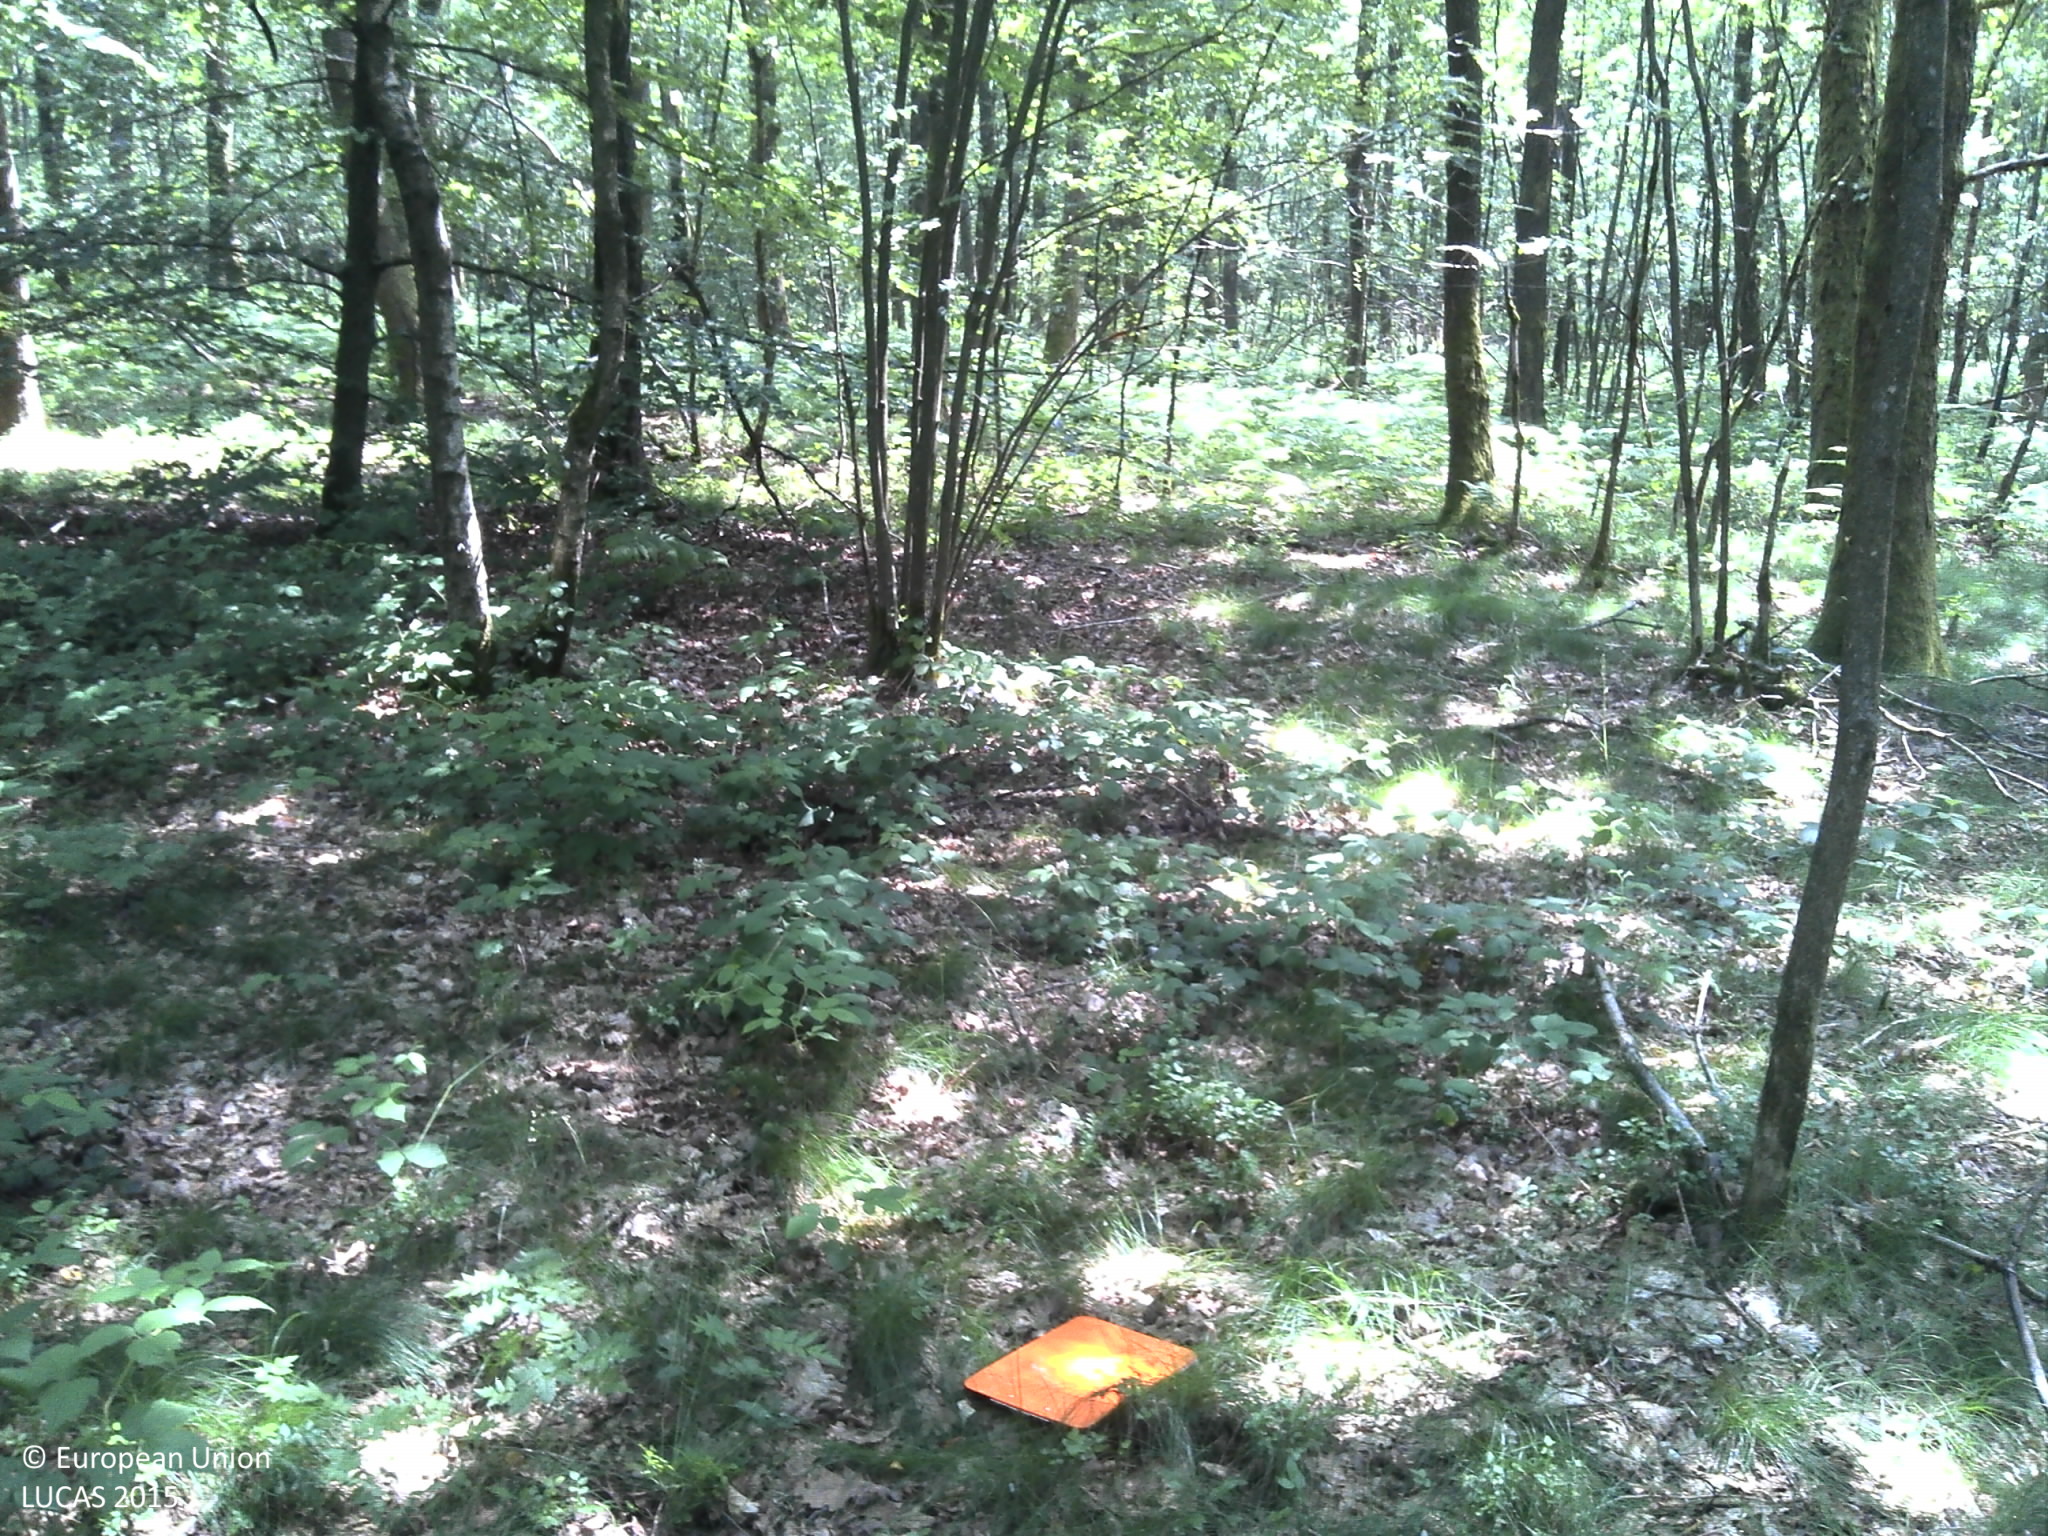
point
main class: Woodland
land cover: Broadleaved woodland
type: acidophilous oak and oak-birch forest
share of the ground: 50 - 75 %
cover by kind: broadleaved forest trees 70 %, herbaceous plants 25 %, consolidated bare surface 5 %
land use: Forestry
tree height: > 5 m
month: July
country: FR
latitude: 49.9203
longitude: 4.7738
